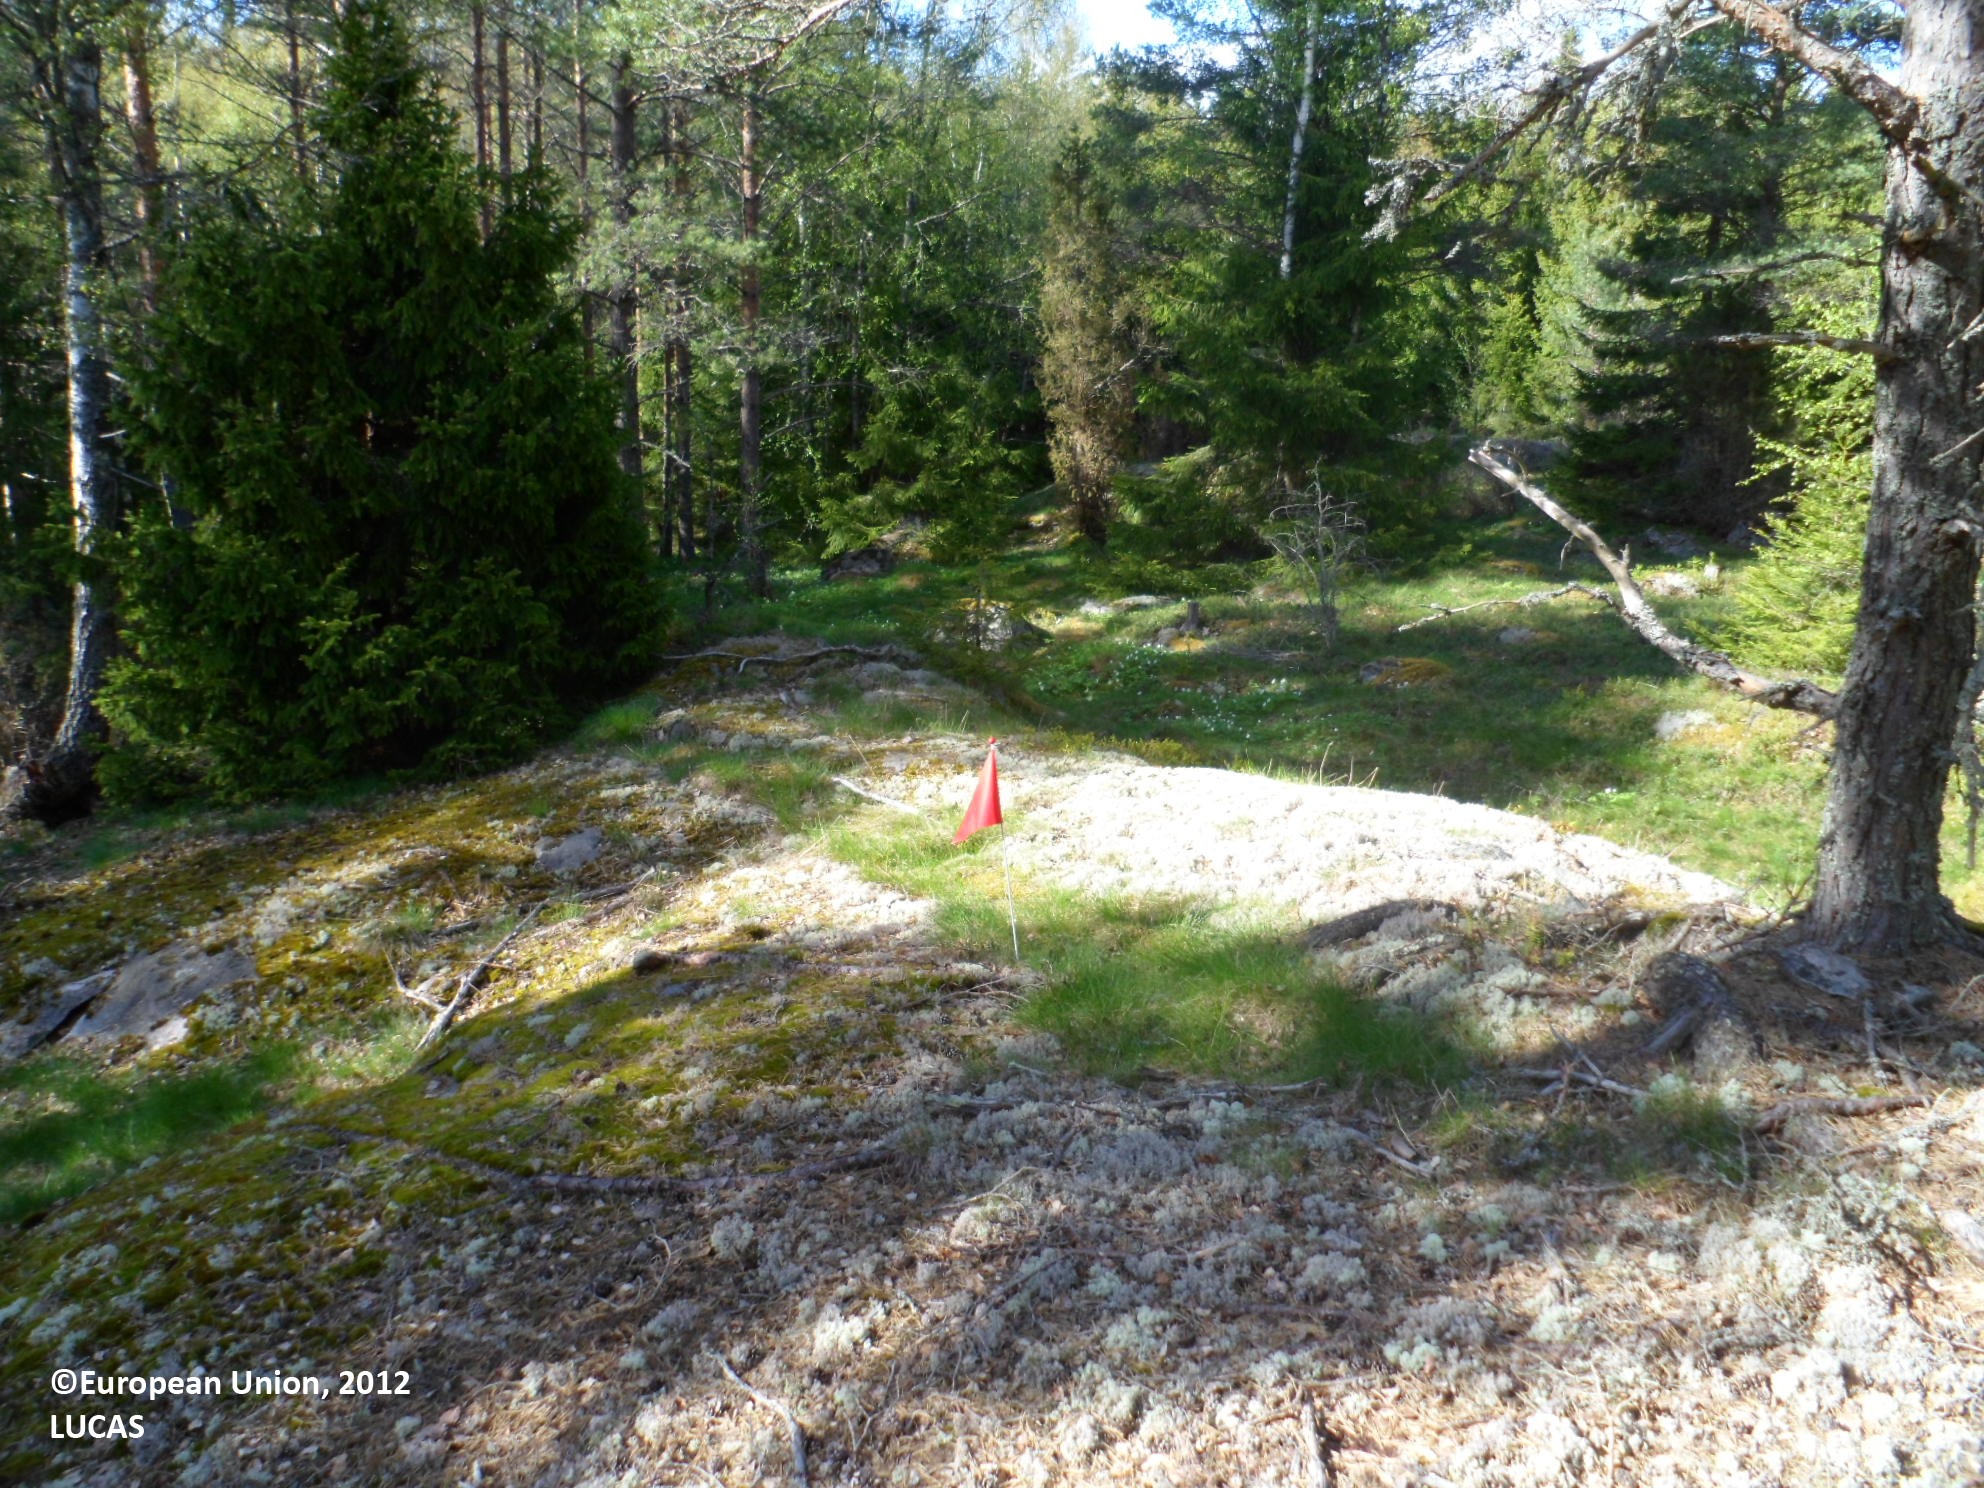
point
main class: Woodland
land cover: Pine dominated coniferous woodland
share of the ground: 25 - 50 %
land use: Forestry
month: May
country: SE
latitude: 59.6993
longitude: 18.6178
